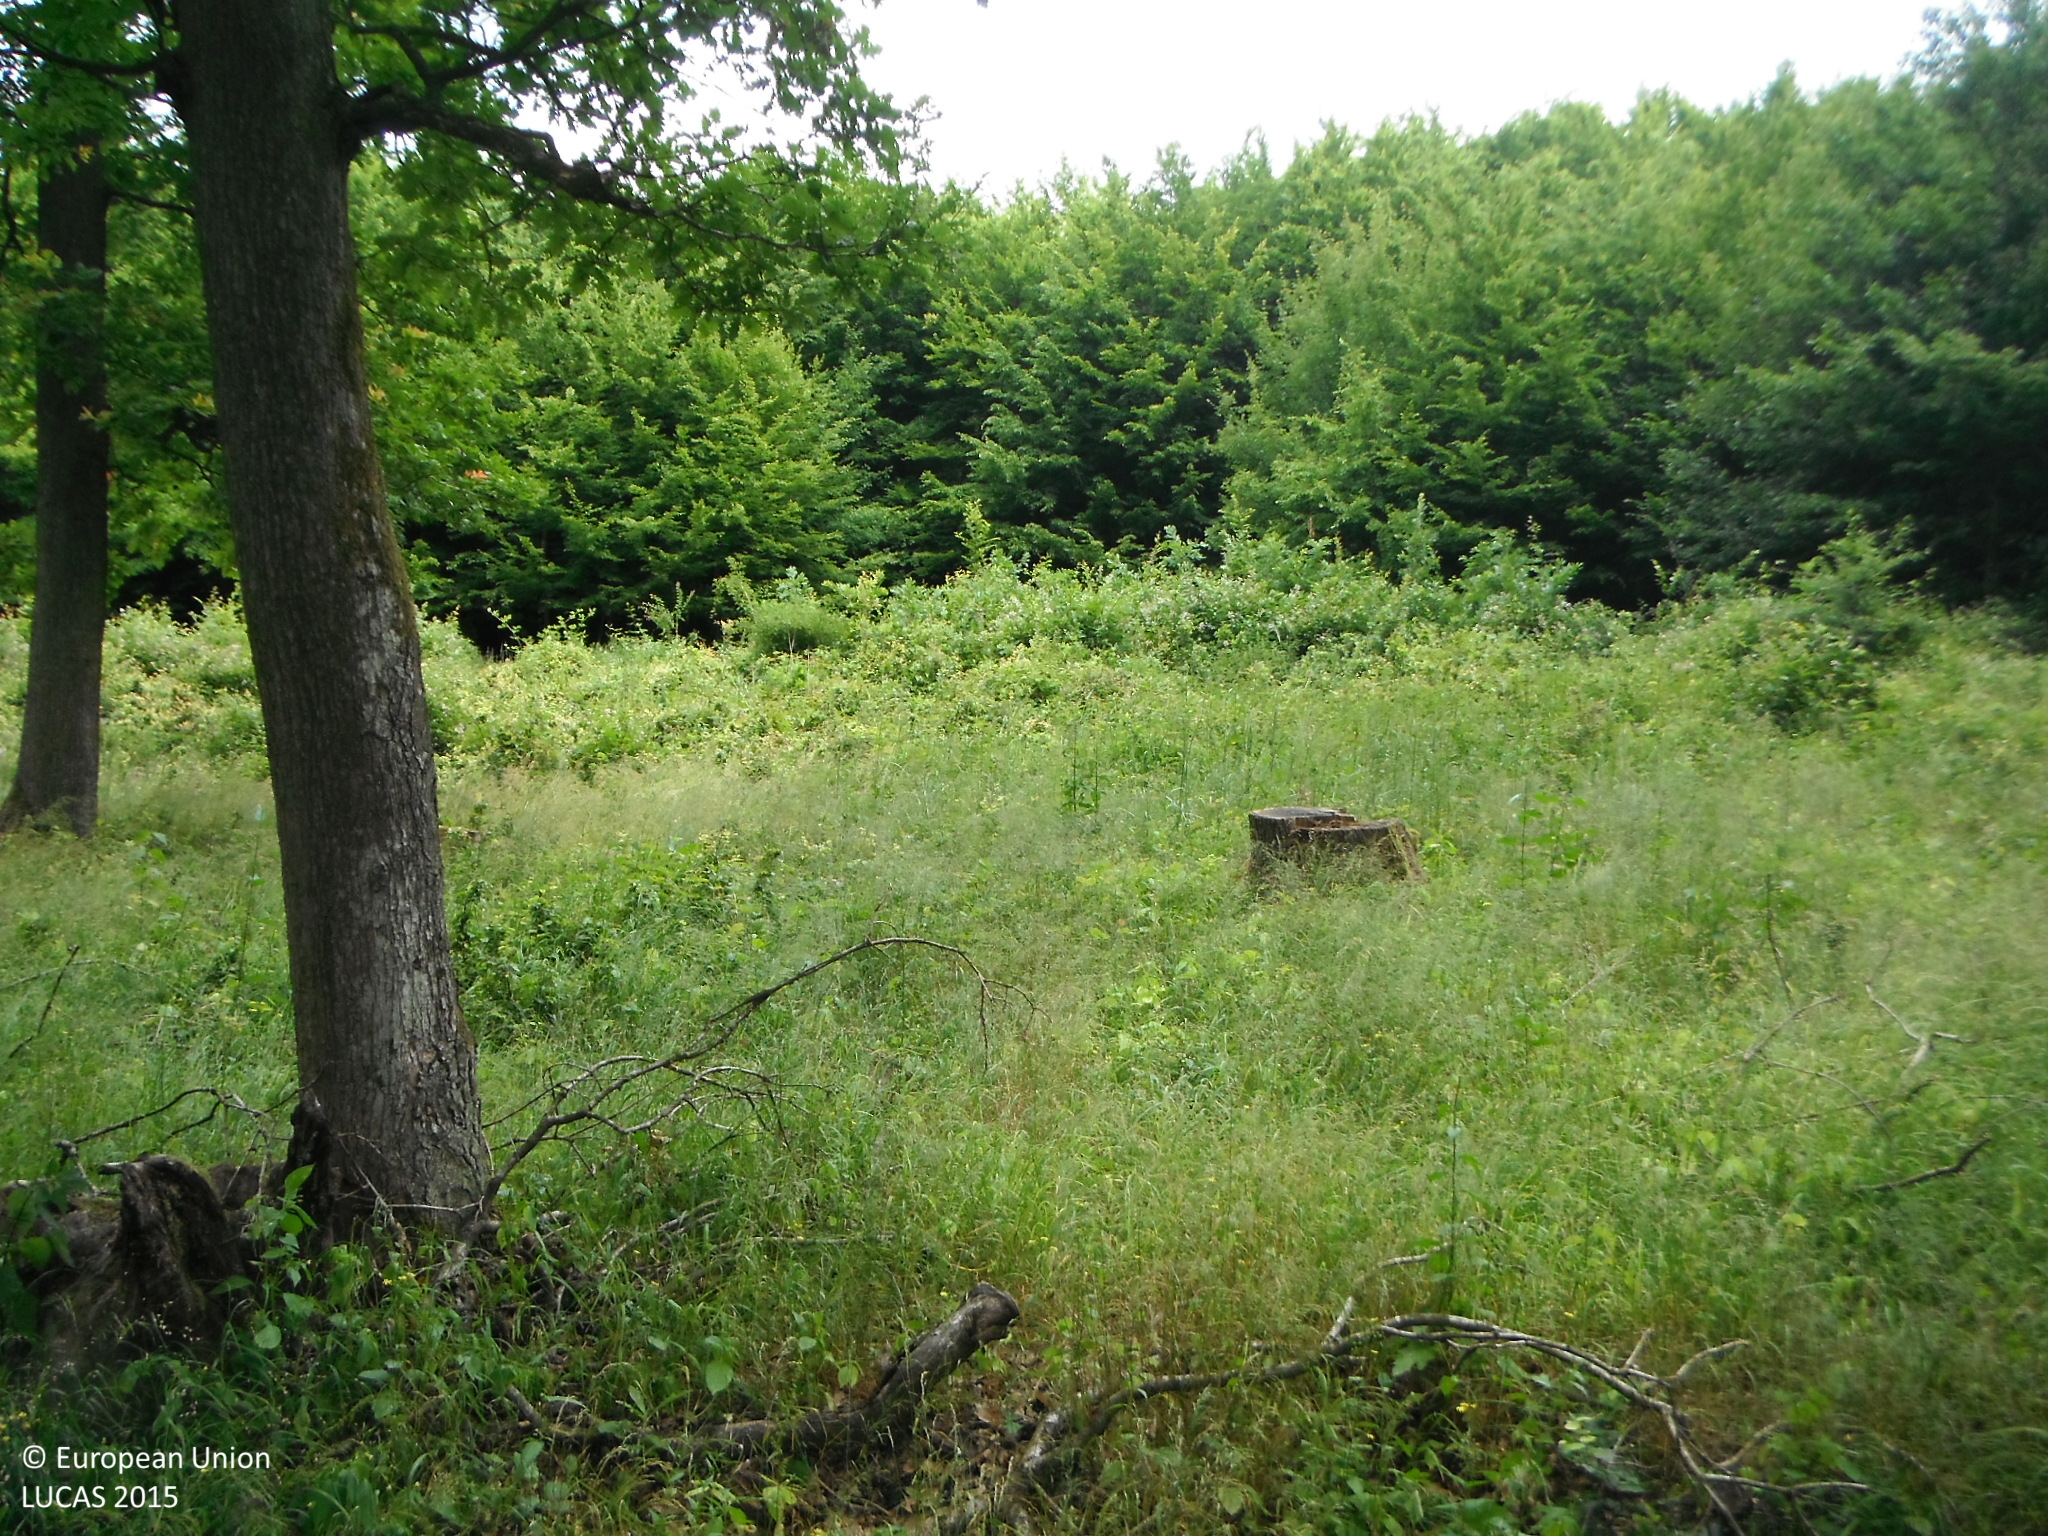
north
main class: Woodland
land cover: Broadleaved woodland
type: mesophytic deciduous forest
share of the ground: > 75 %
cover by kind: broadleaved forest trees 80 %, herbaceous plants 15 %, shrubs 5 %
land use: Forestry
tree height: > 5 m
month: June
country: SK
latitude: 48.5478
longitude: 17.4747
